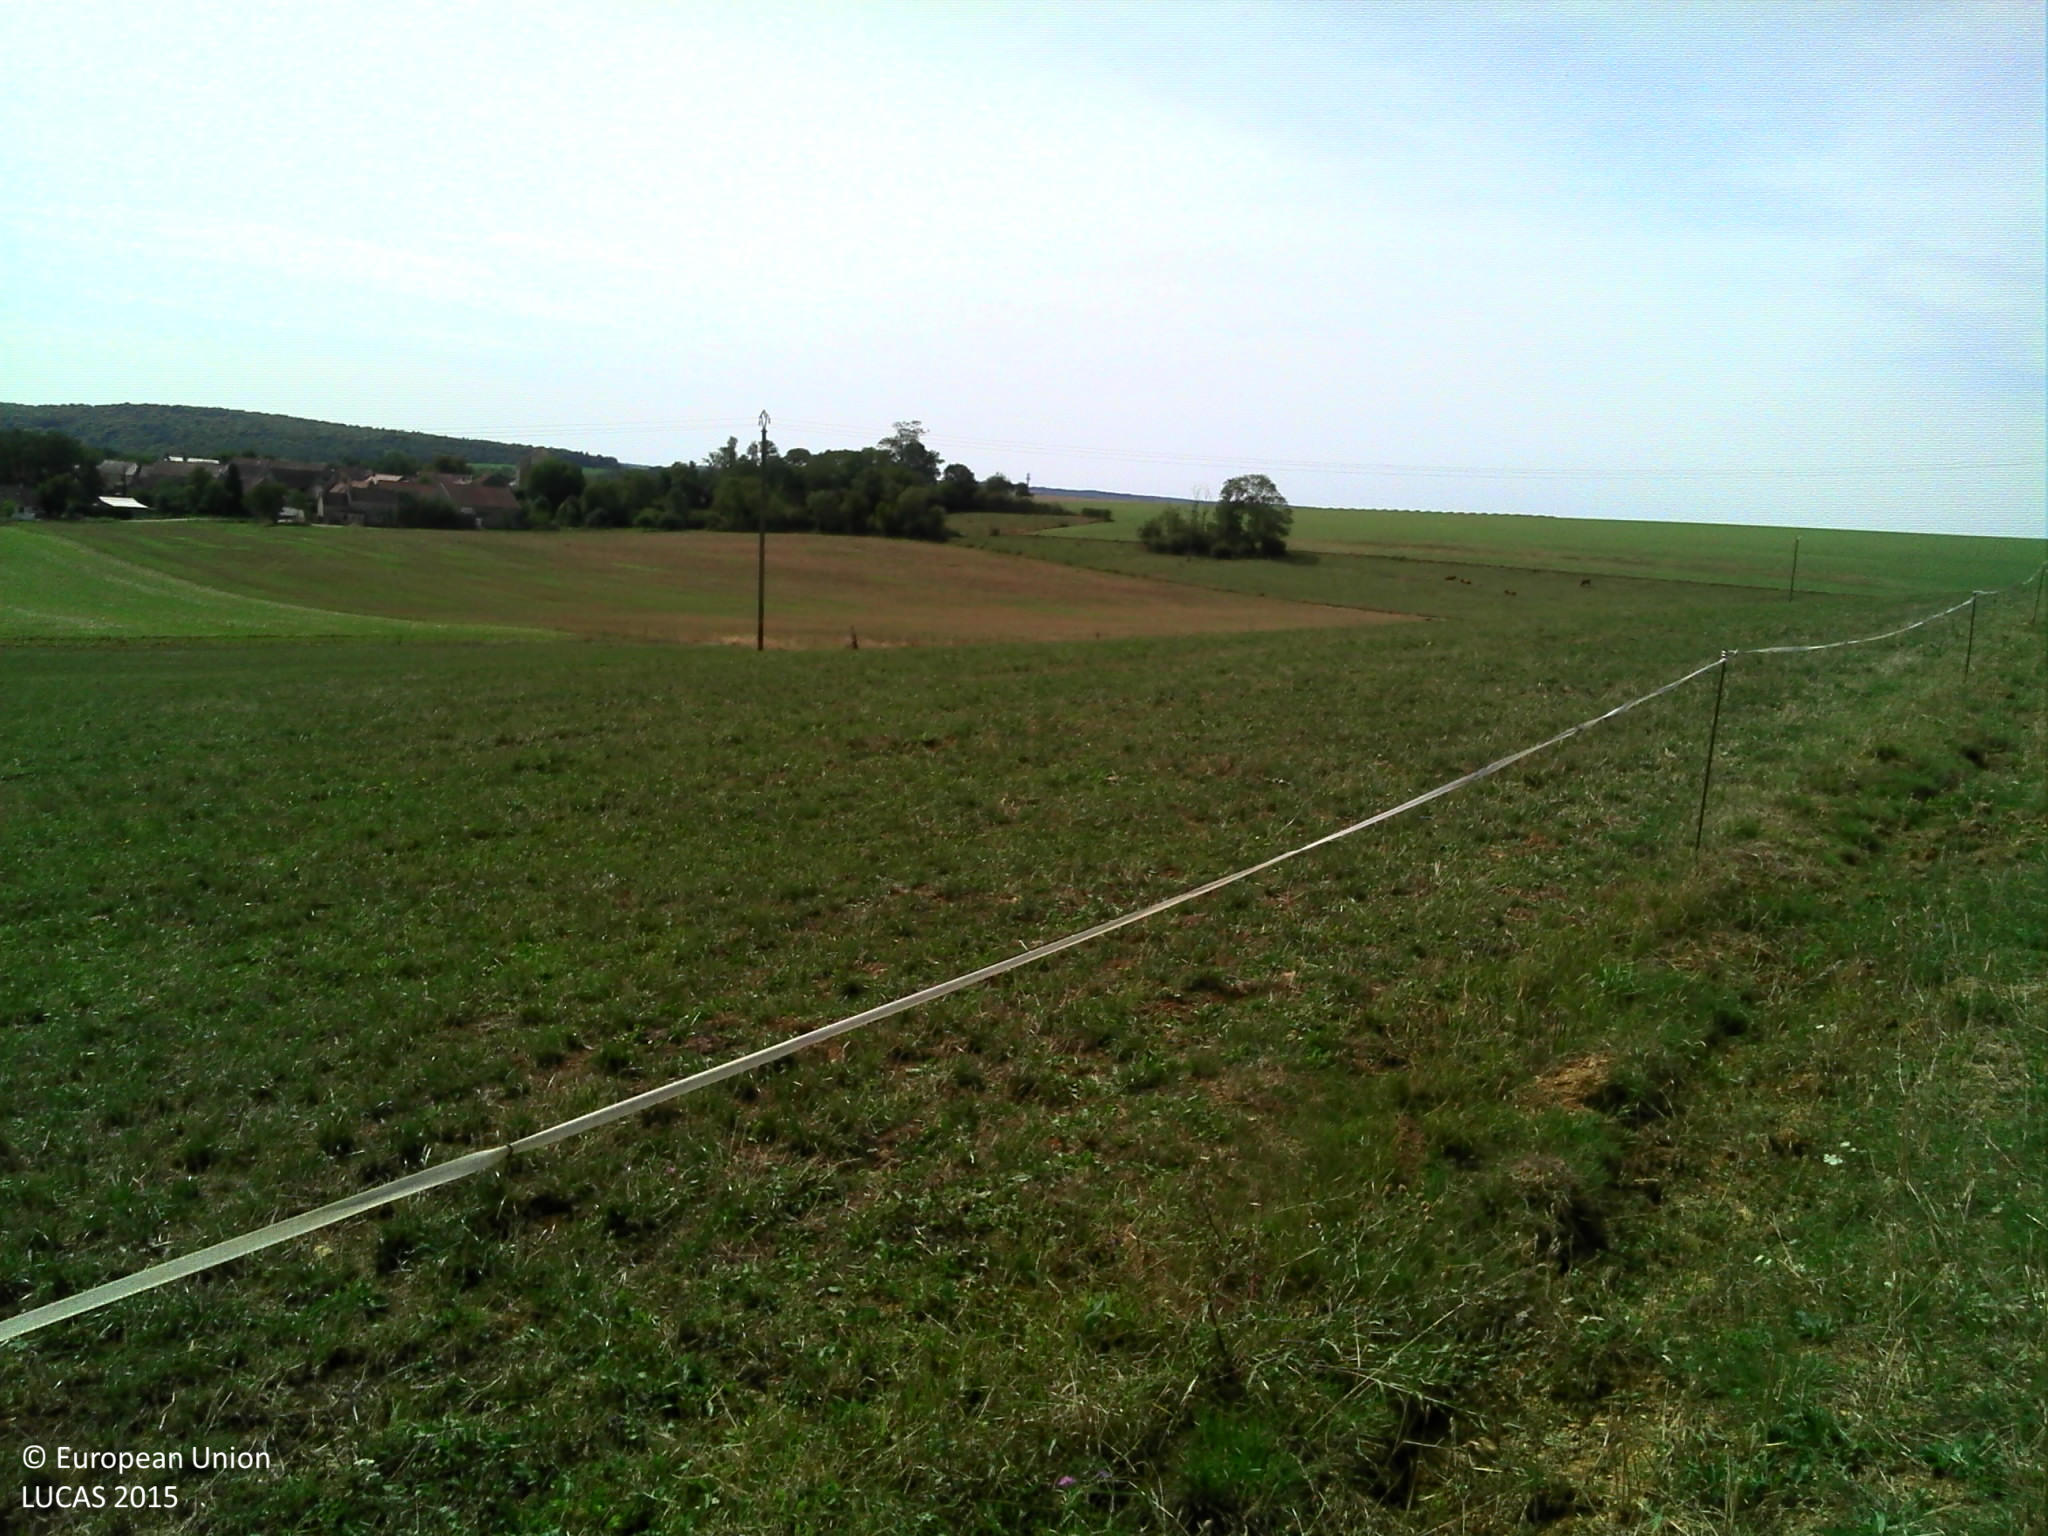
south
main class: Cropland
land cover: Oats
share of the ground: > 75 %
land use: Agriculture (excluding fallow land and kitchen gardens)
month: August
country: FR
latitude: 47.6572
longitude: 4.9534
